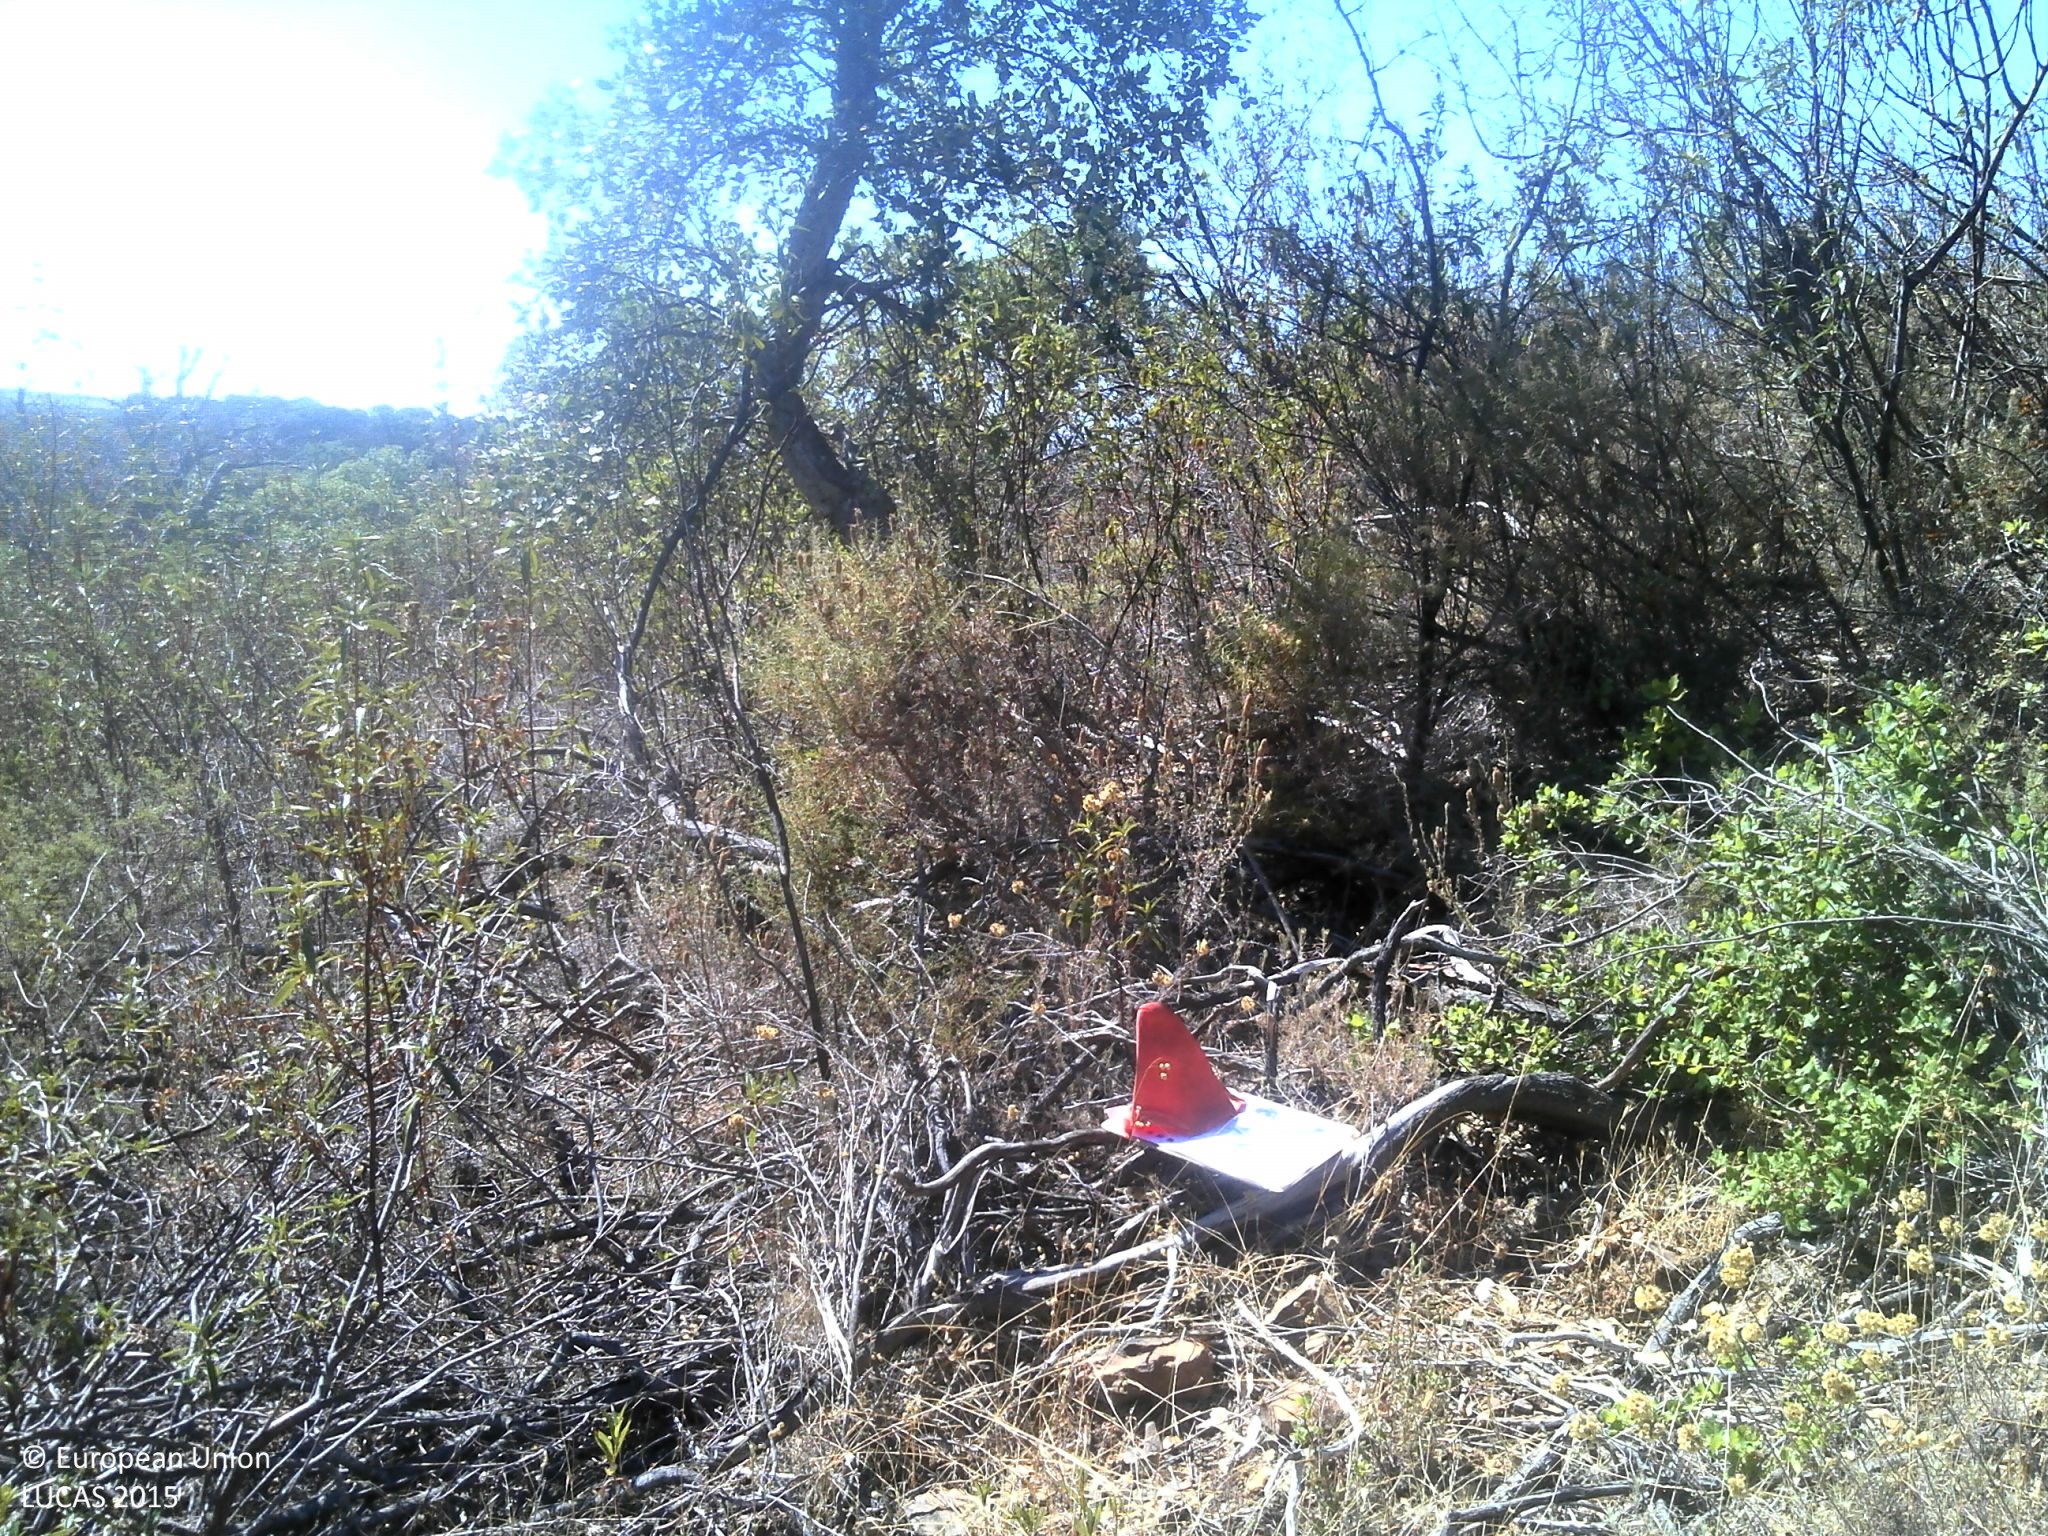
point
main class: Woodland
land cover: Broadleaved woodland
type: broadleaved evergreen forest
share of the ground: 25 - 50 %
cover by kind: shrubs 35 %, unconsolidated bare surface 35 %, broadleaved forest trees 30 %
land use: Forestry
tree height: > 5 m
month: August
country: PT
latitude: 37.1611
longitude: -8.7582
